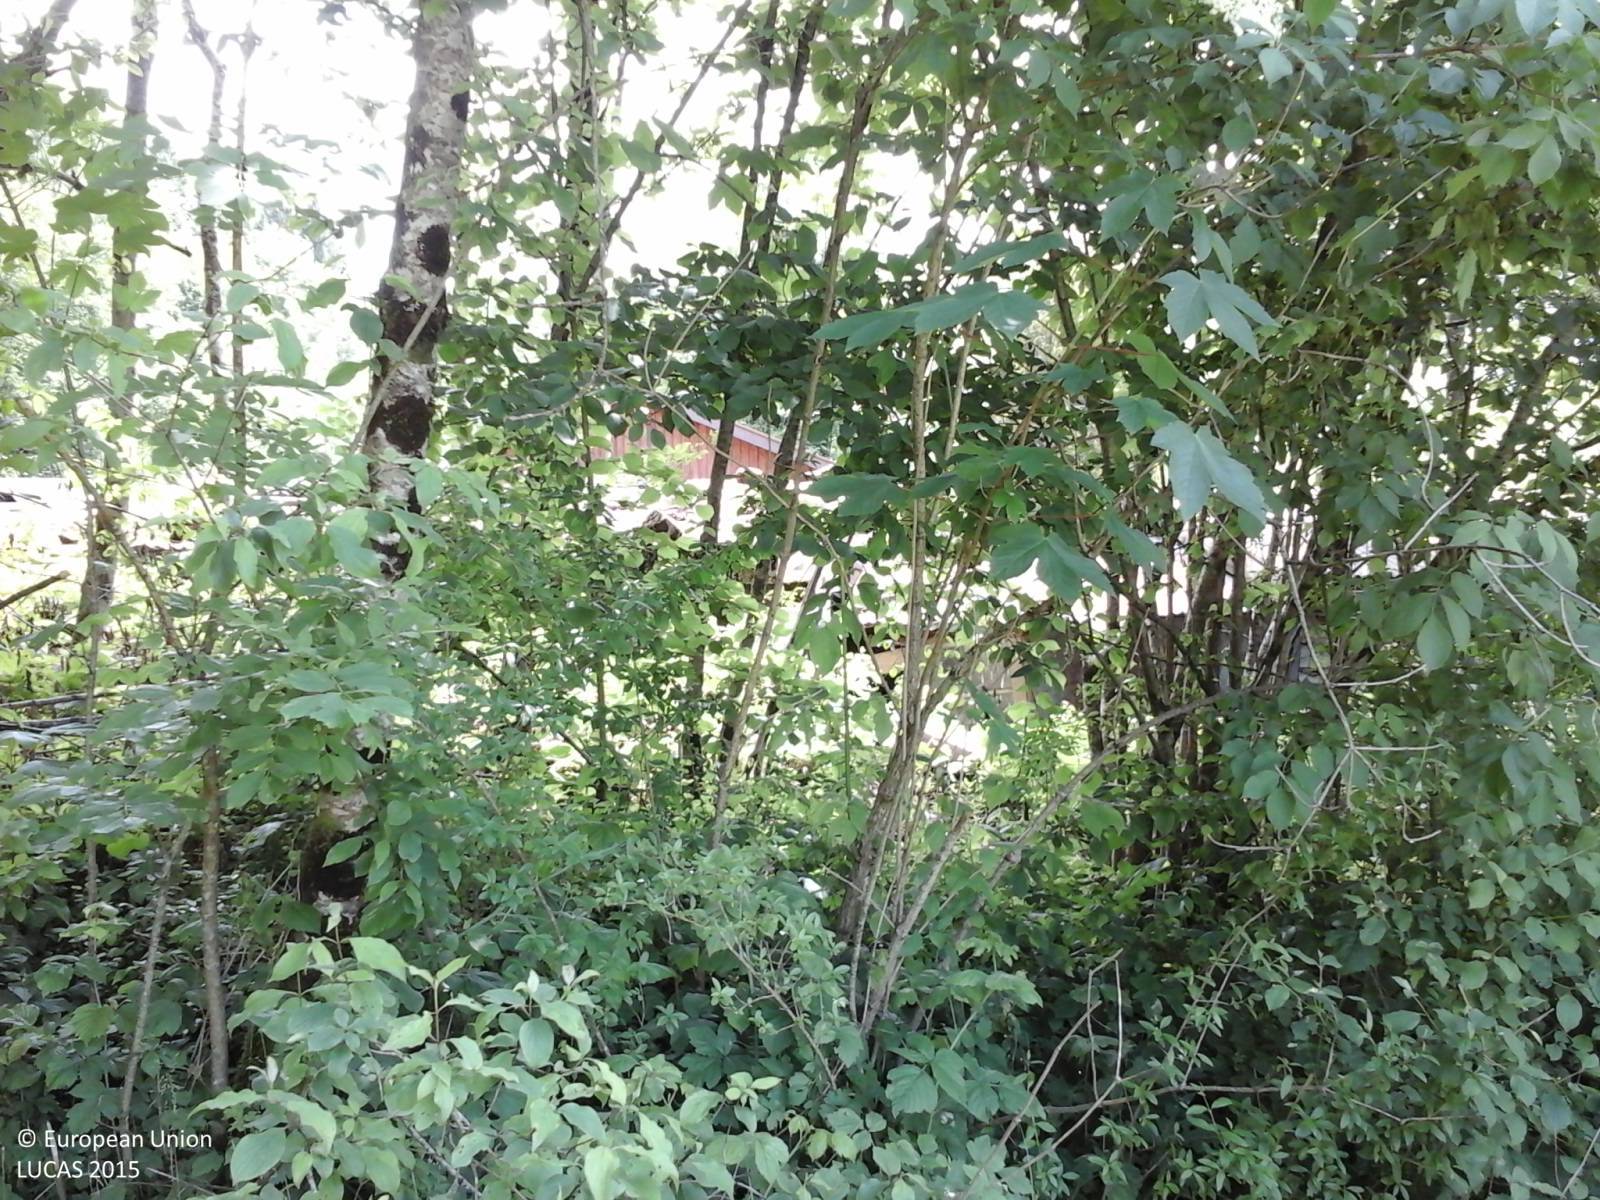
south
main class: Woodland
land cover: Broadleaved woodland
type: thermophilous deciduous forest
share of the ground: > 75 %
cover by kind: broadleaved forest trees 75 %, coniferous forest trees 25 %
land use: Forestry
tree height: > 5 m
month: May
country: IT
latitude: 46.2657
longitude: 13.2533
